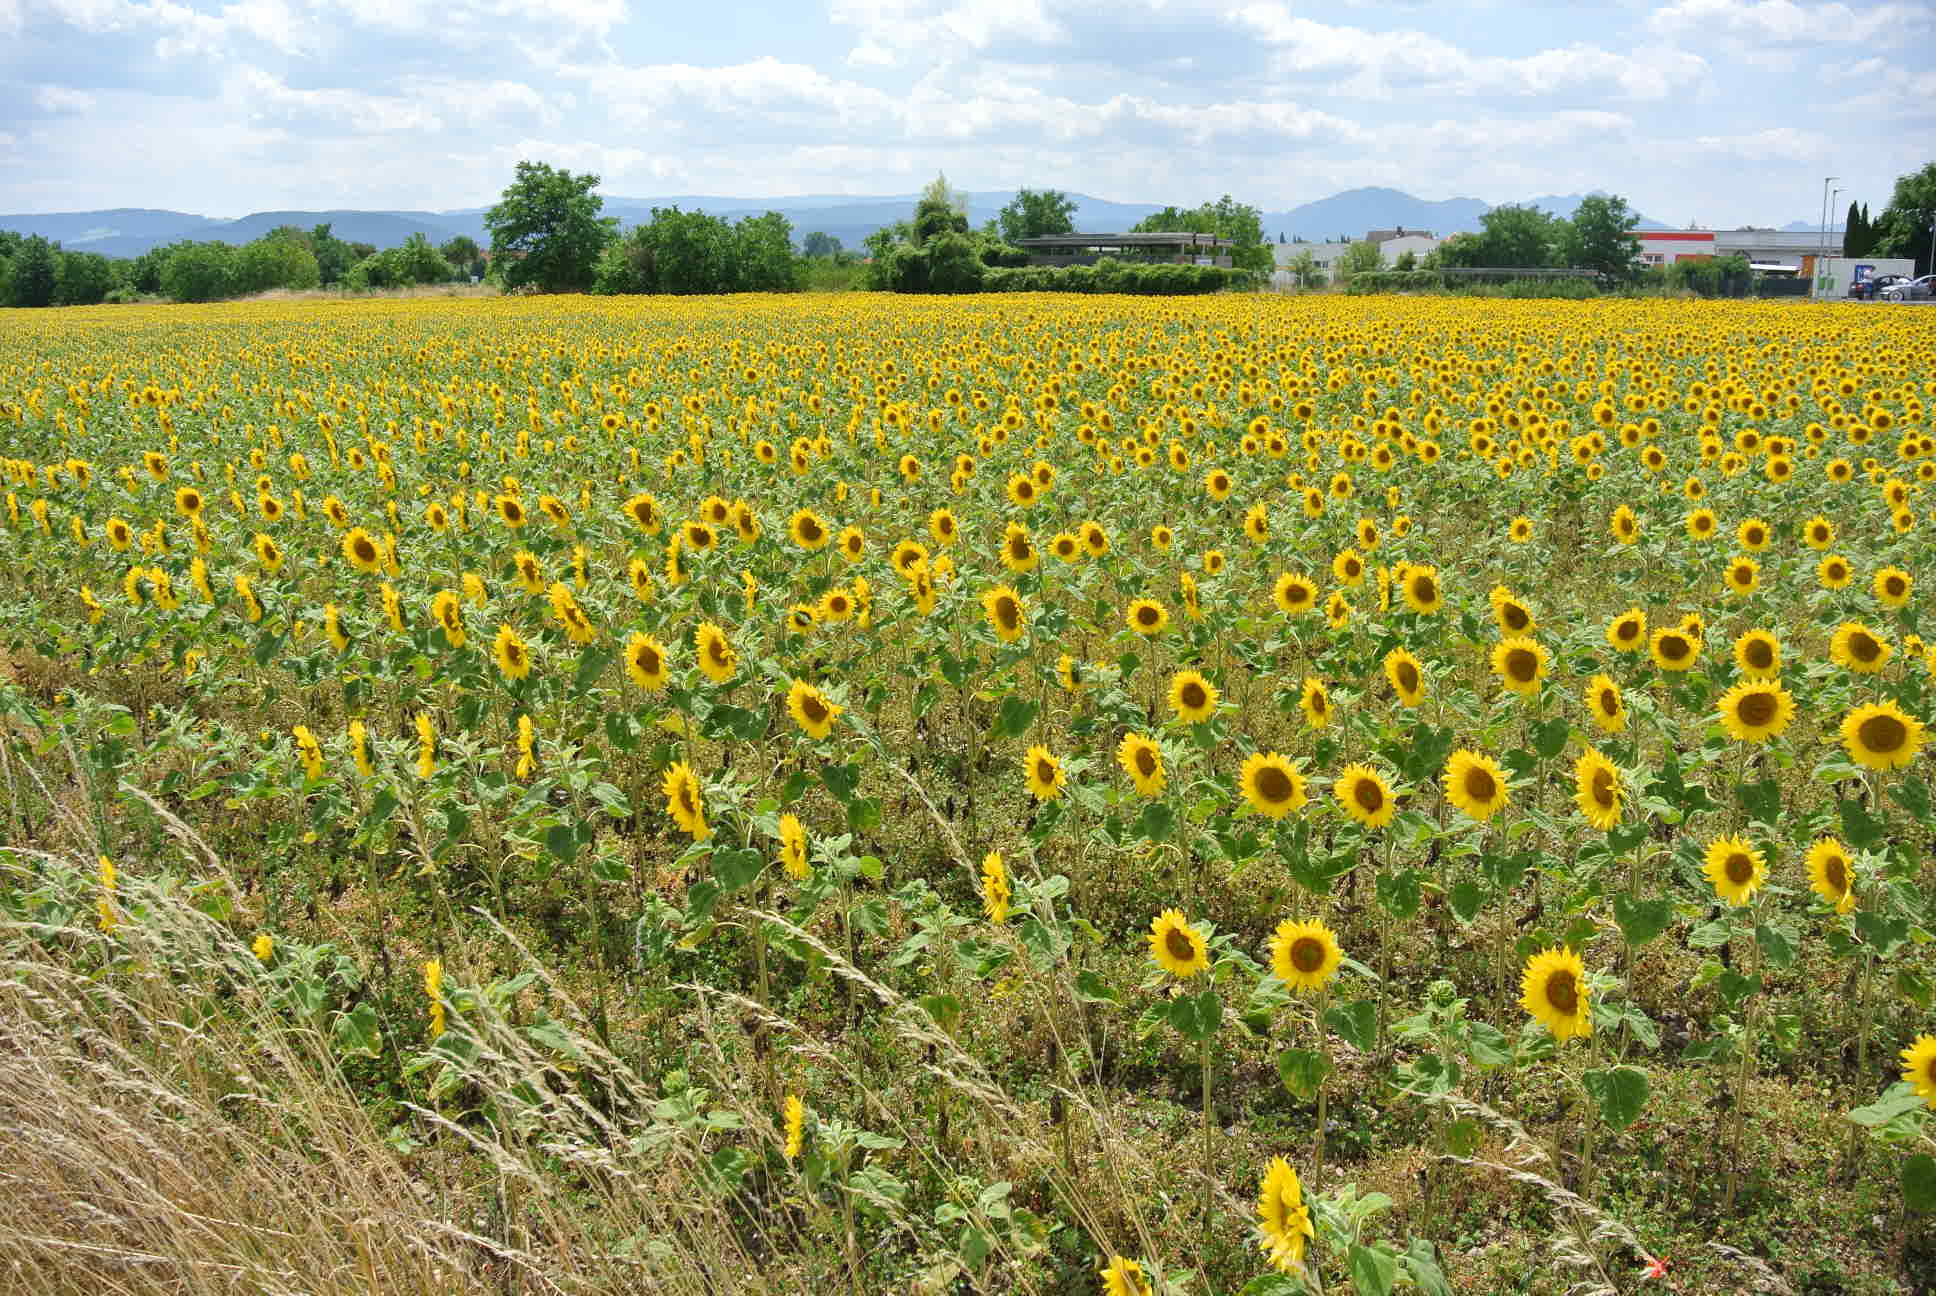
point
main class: Cropland
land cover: Sunflower
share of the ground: > 75 %
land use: Agriculture (excluding fallow land and kitchen gardens)
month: July
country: AT
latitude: 47.7300
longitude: 16.0964
